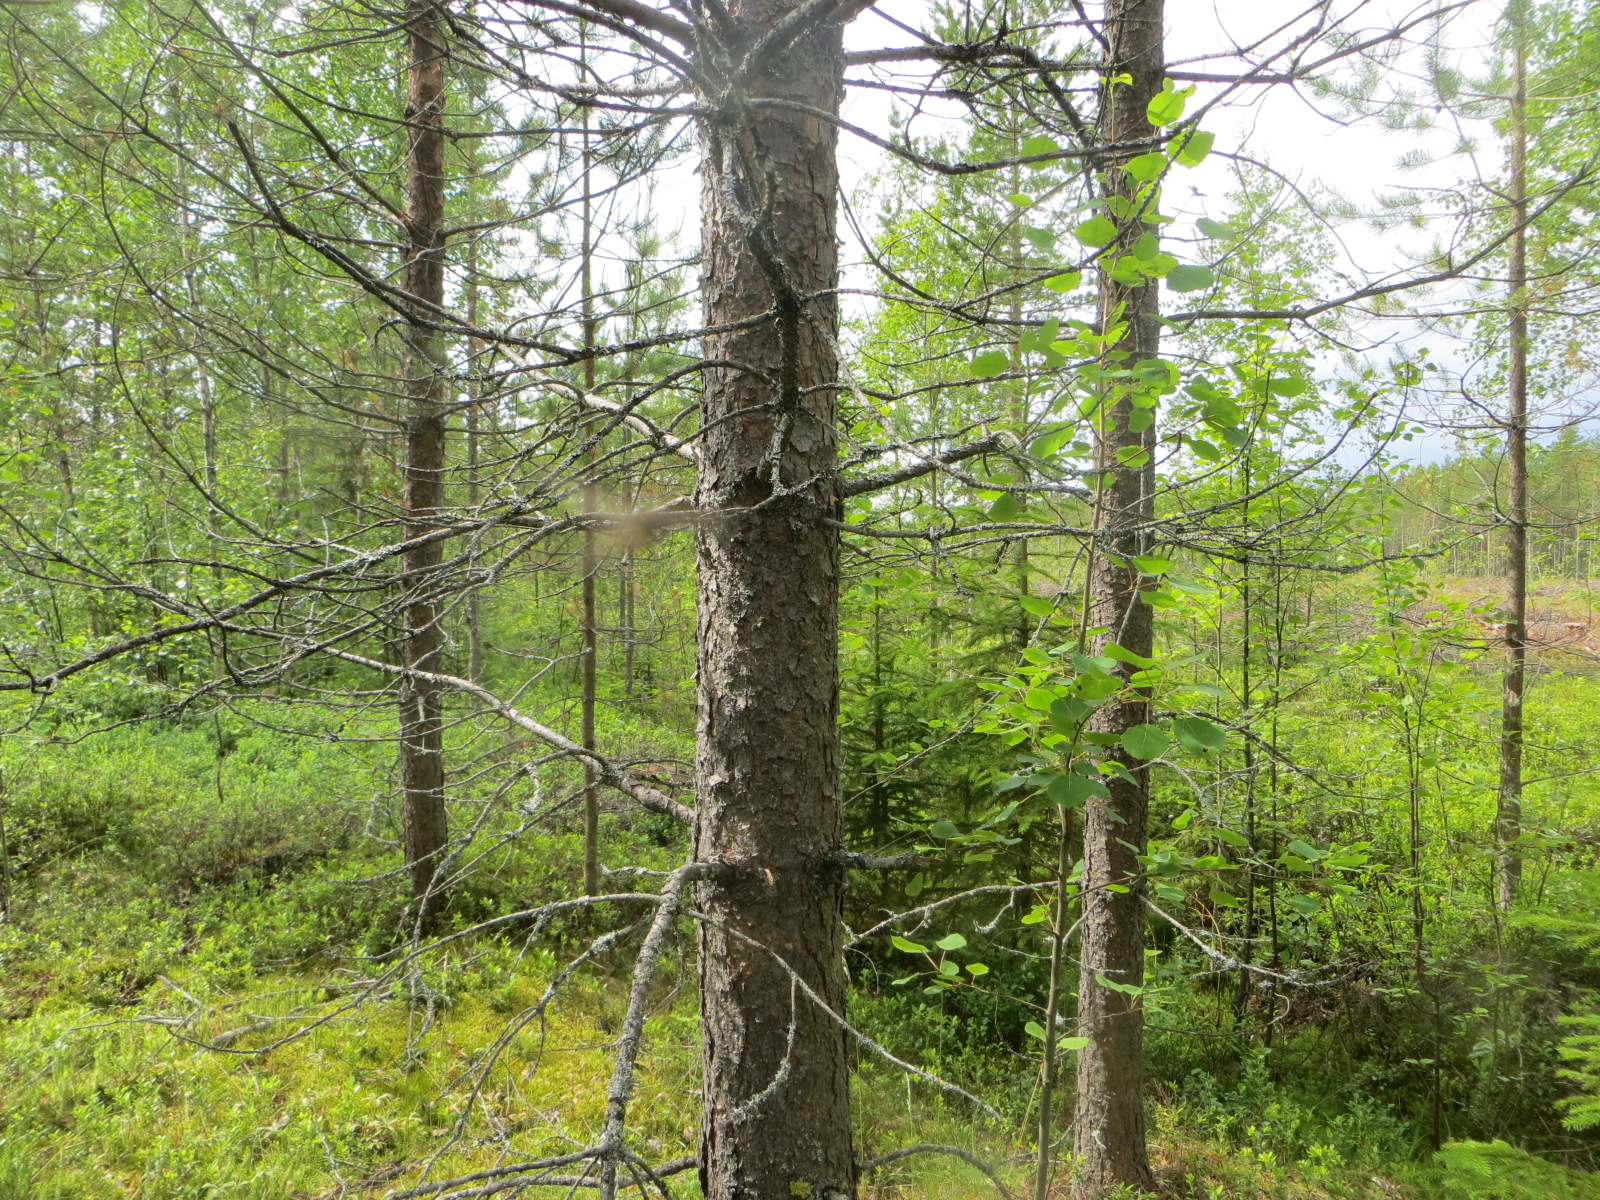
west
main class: Woodland
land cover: Pine dominated mixed woodland
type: boreal forest
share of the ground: > 75 %
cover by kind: coniferous forest trees 50 %, shrubs 30 %, broadleaved forest trees 20 %
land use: Forestry
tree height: > 5 m
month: July
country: FI
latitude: 65.6111
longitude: 25.2855
